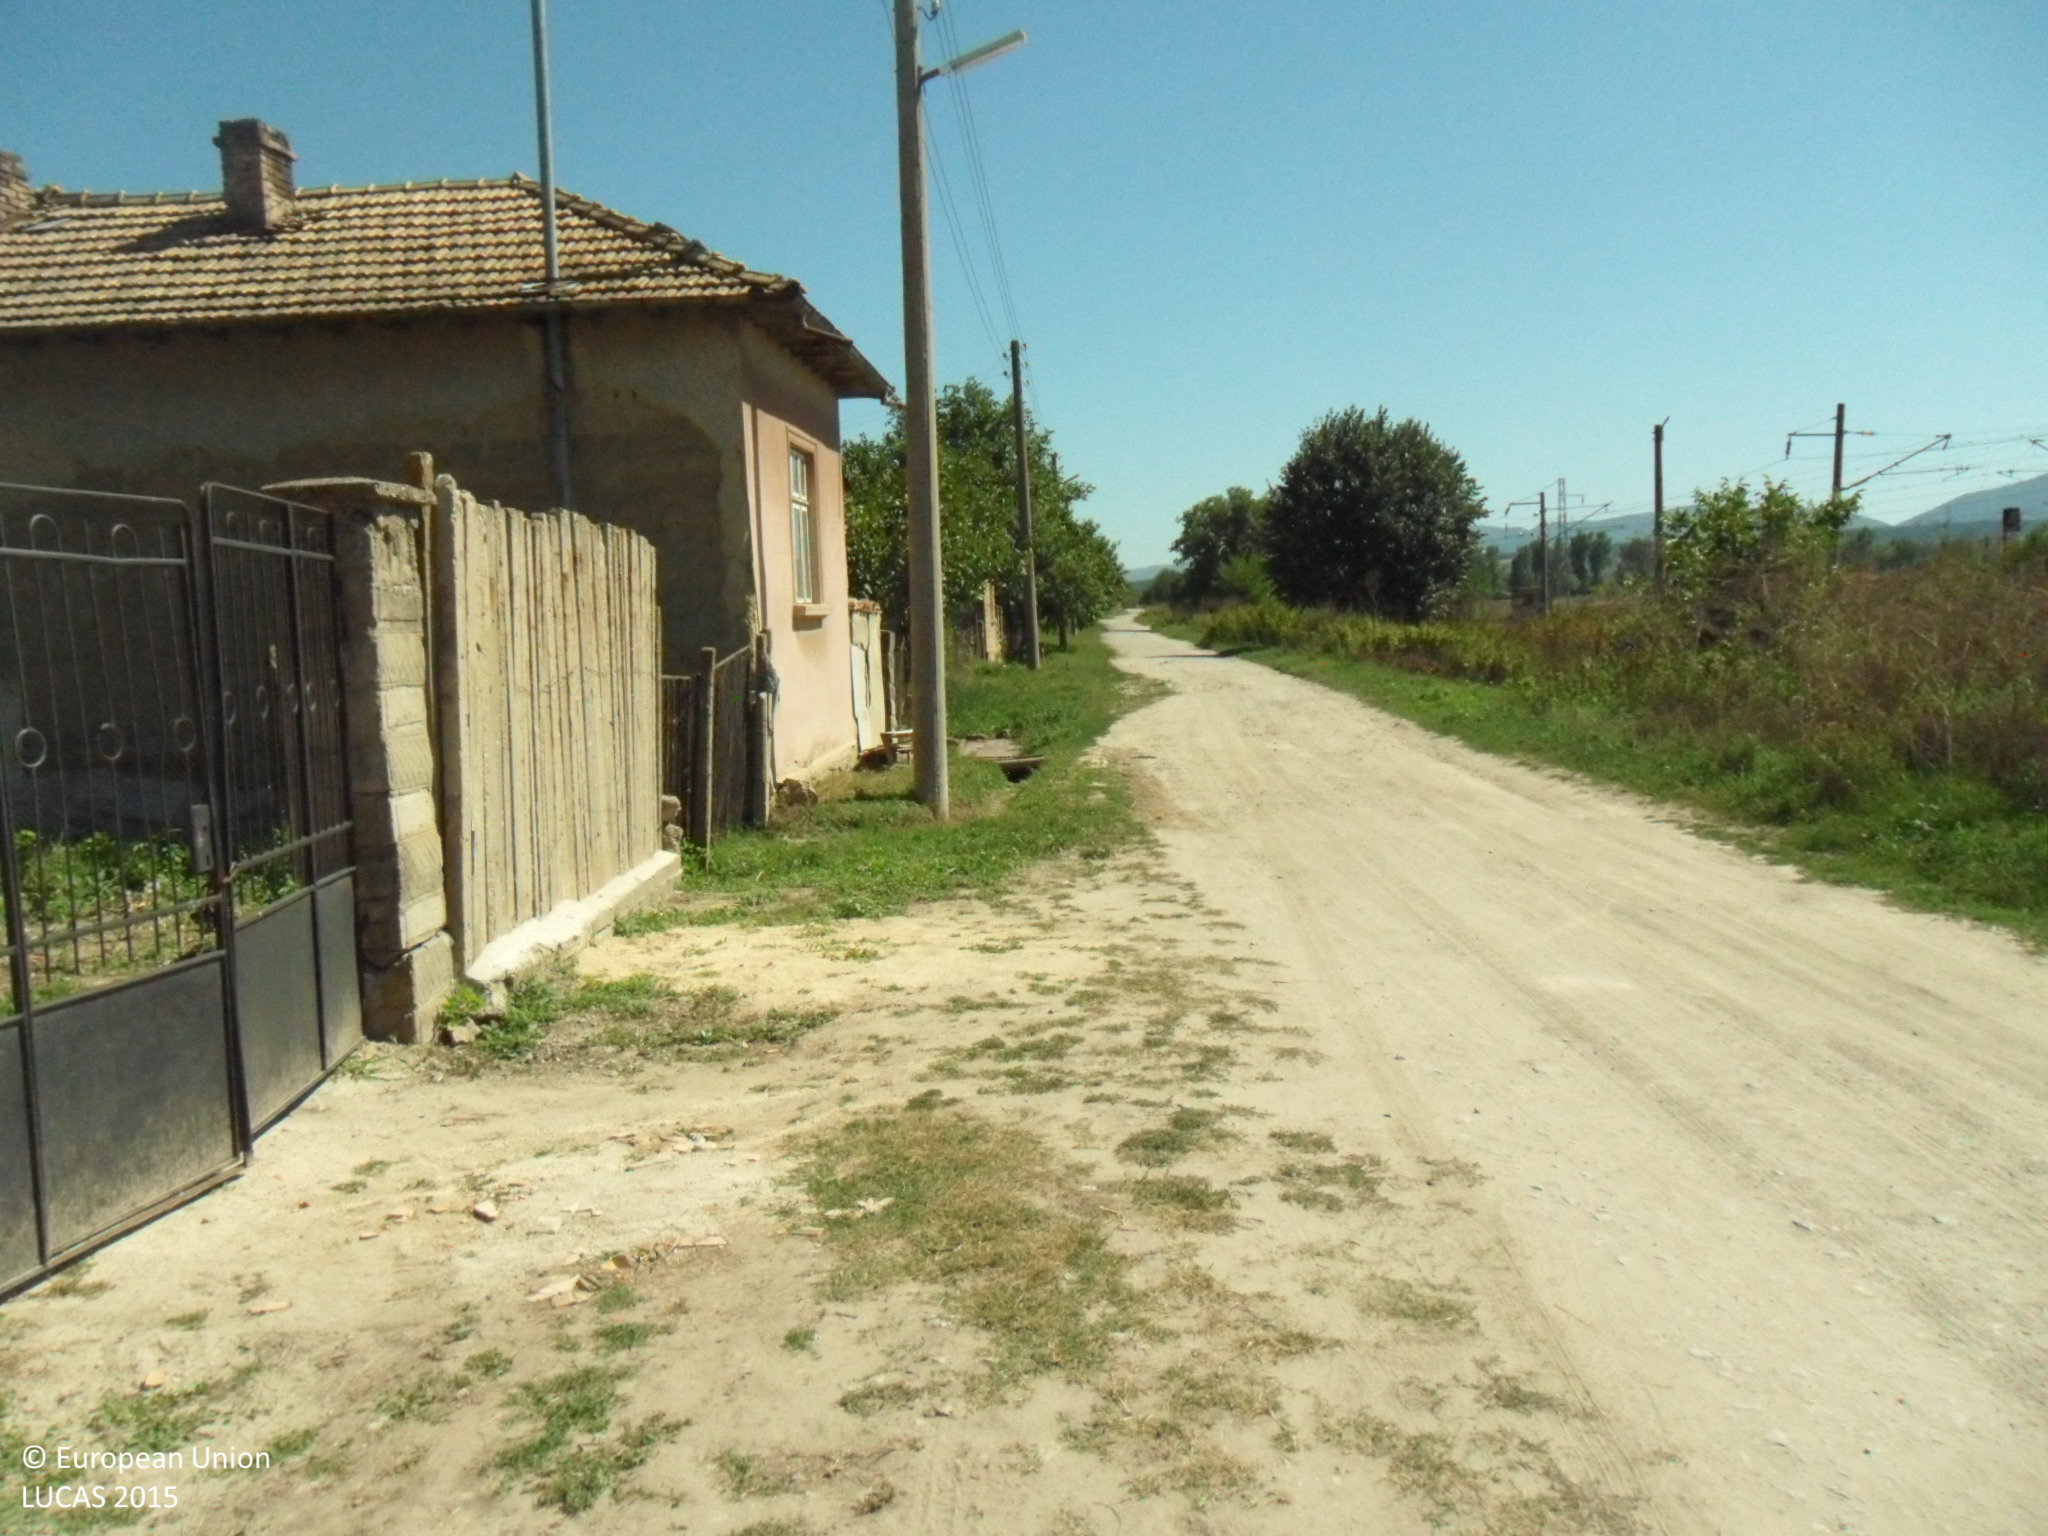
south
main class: Grassland
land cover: Grassland without tree/shrub cover
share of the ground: > 75 %
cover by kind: herbaceous plants 85 %, unconsolidated bare surface 10 %, shrubs 5 %
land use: Residential
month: September
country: BG
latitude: 43.2278
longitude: 26.7919
